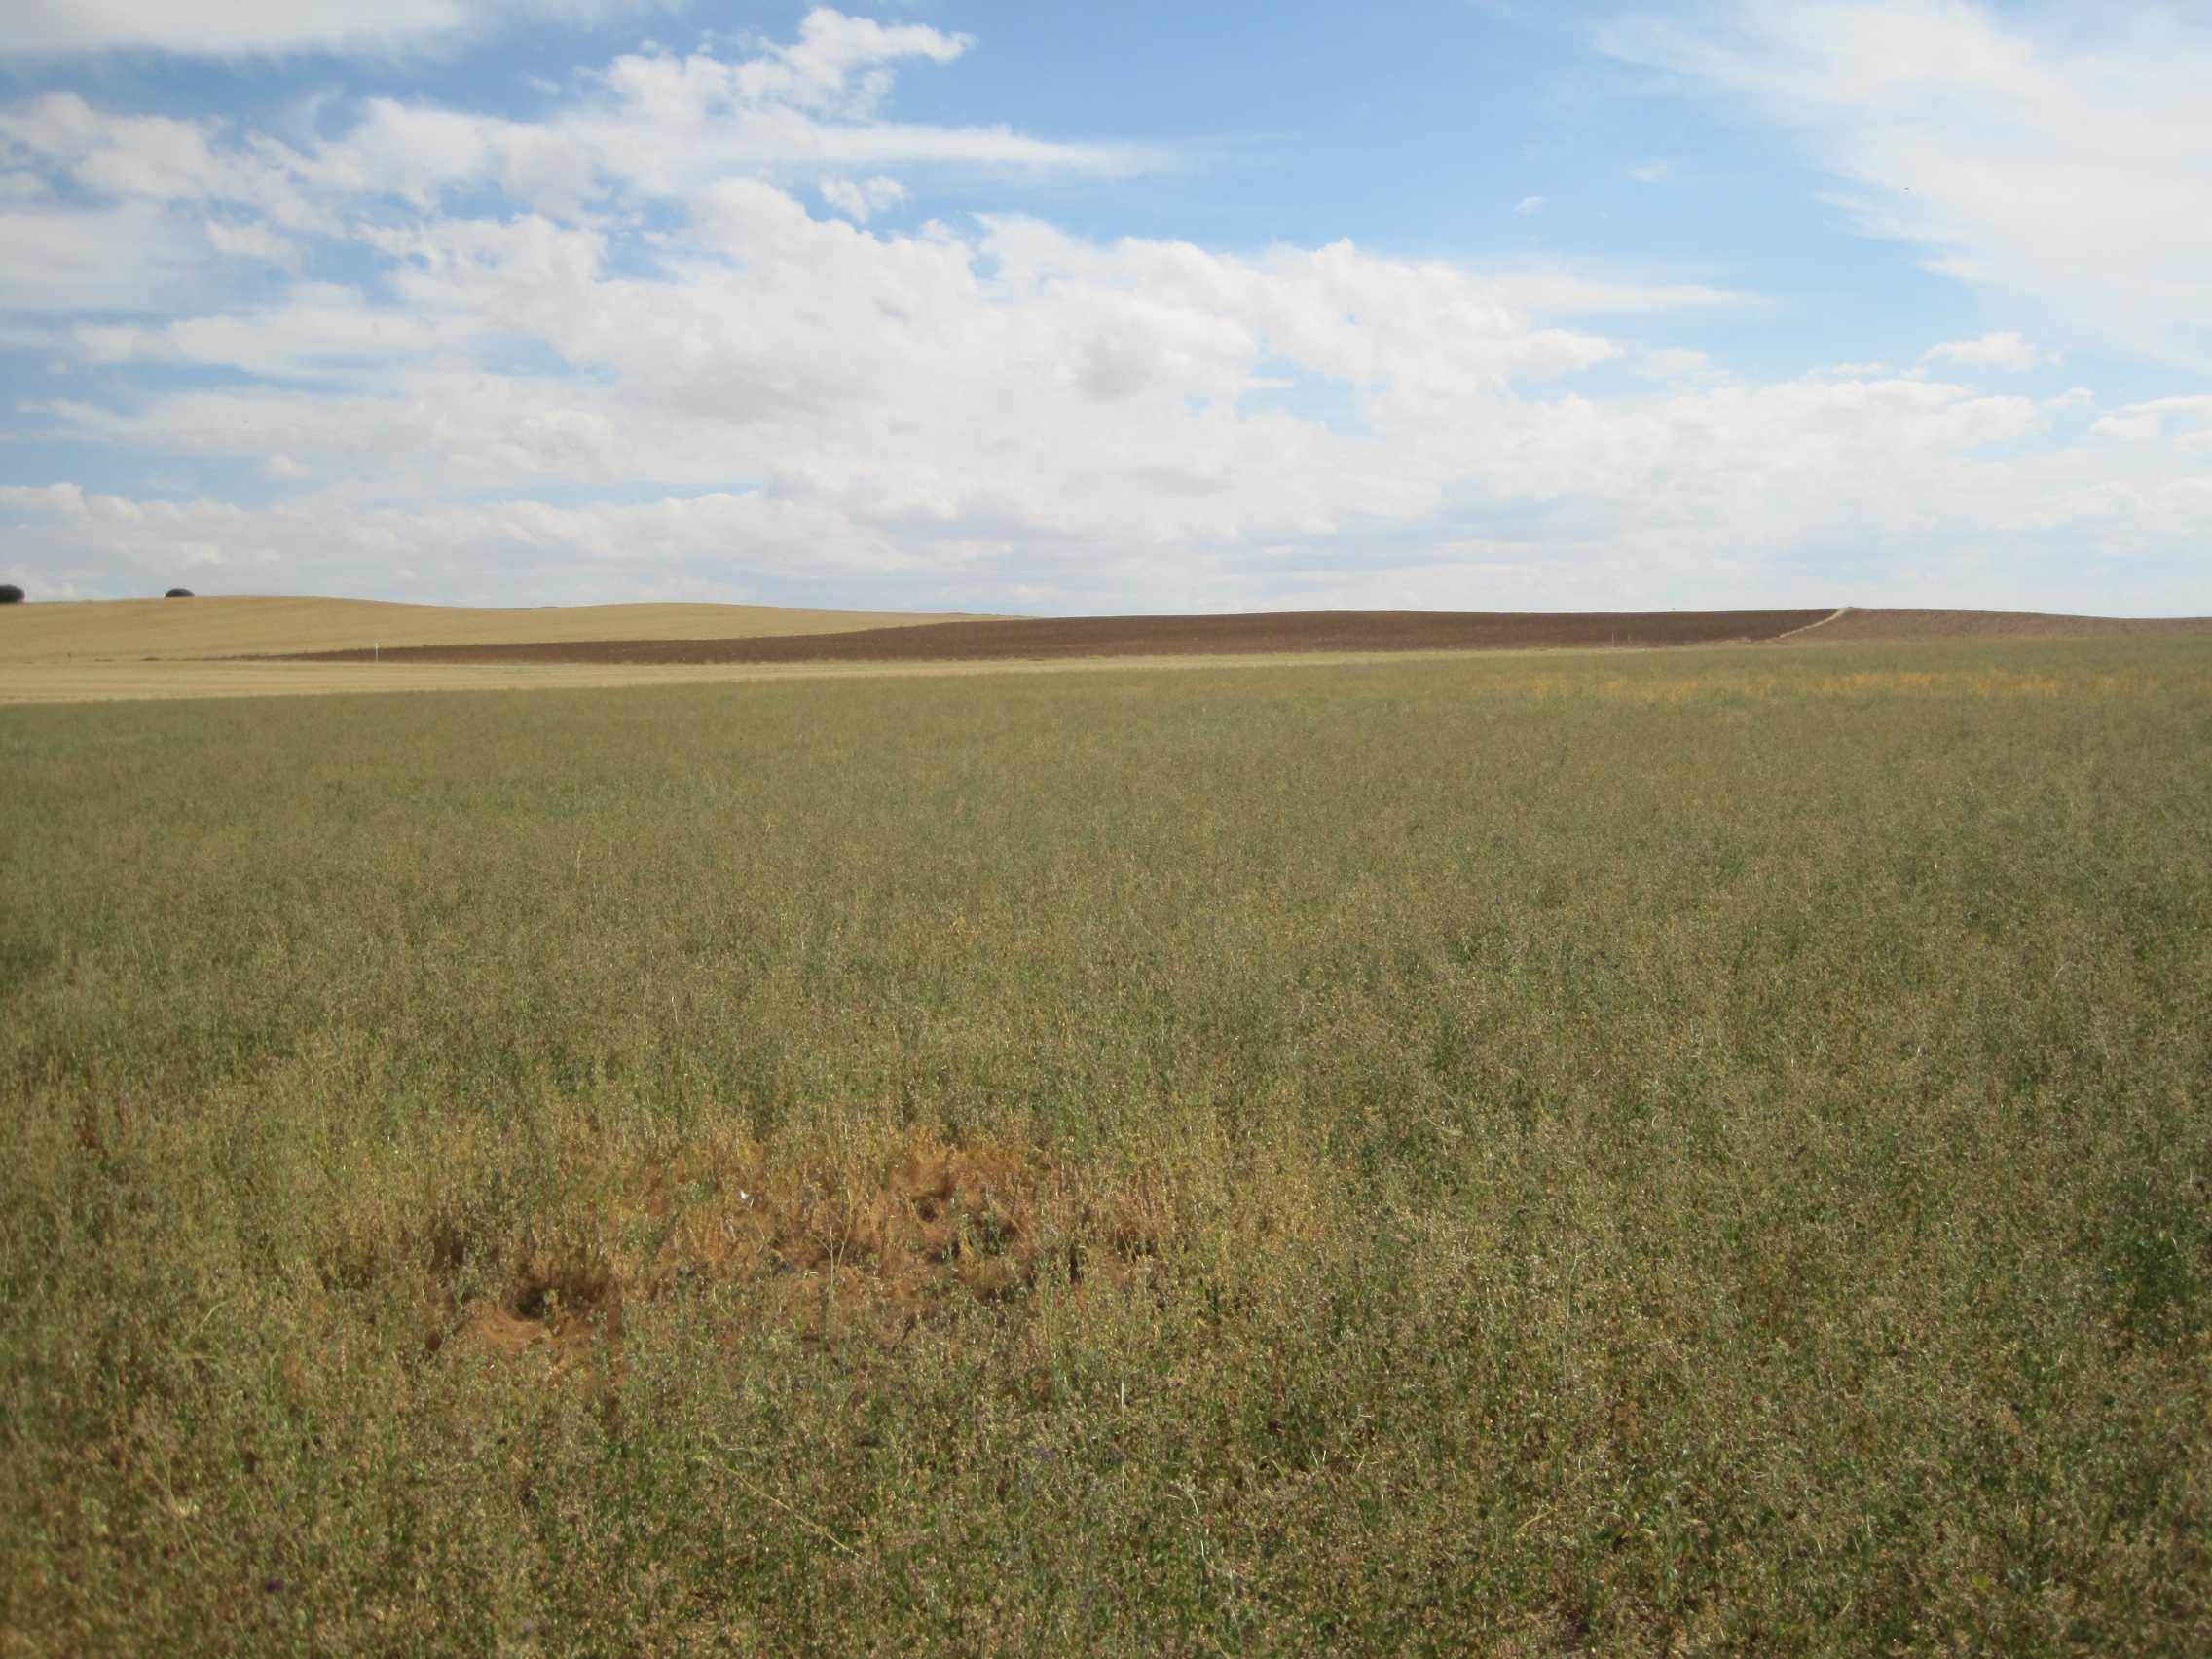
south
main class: Cropland
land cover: Lucerne
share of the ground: > 75 %
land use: Agriculture (excluding fallow land and kitchen gardens)
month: July
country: ES
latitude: 41.9860
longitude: -5.2553
